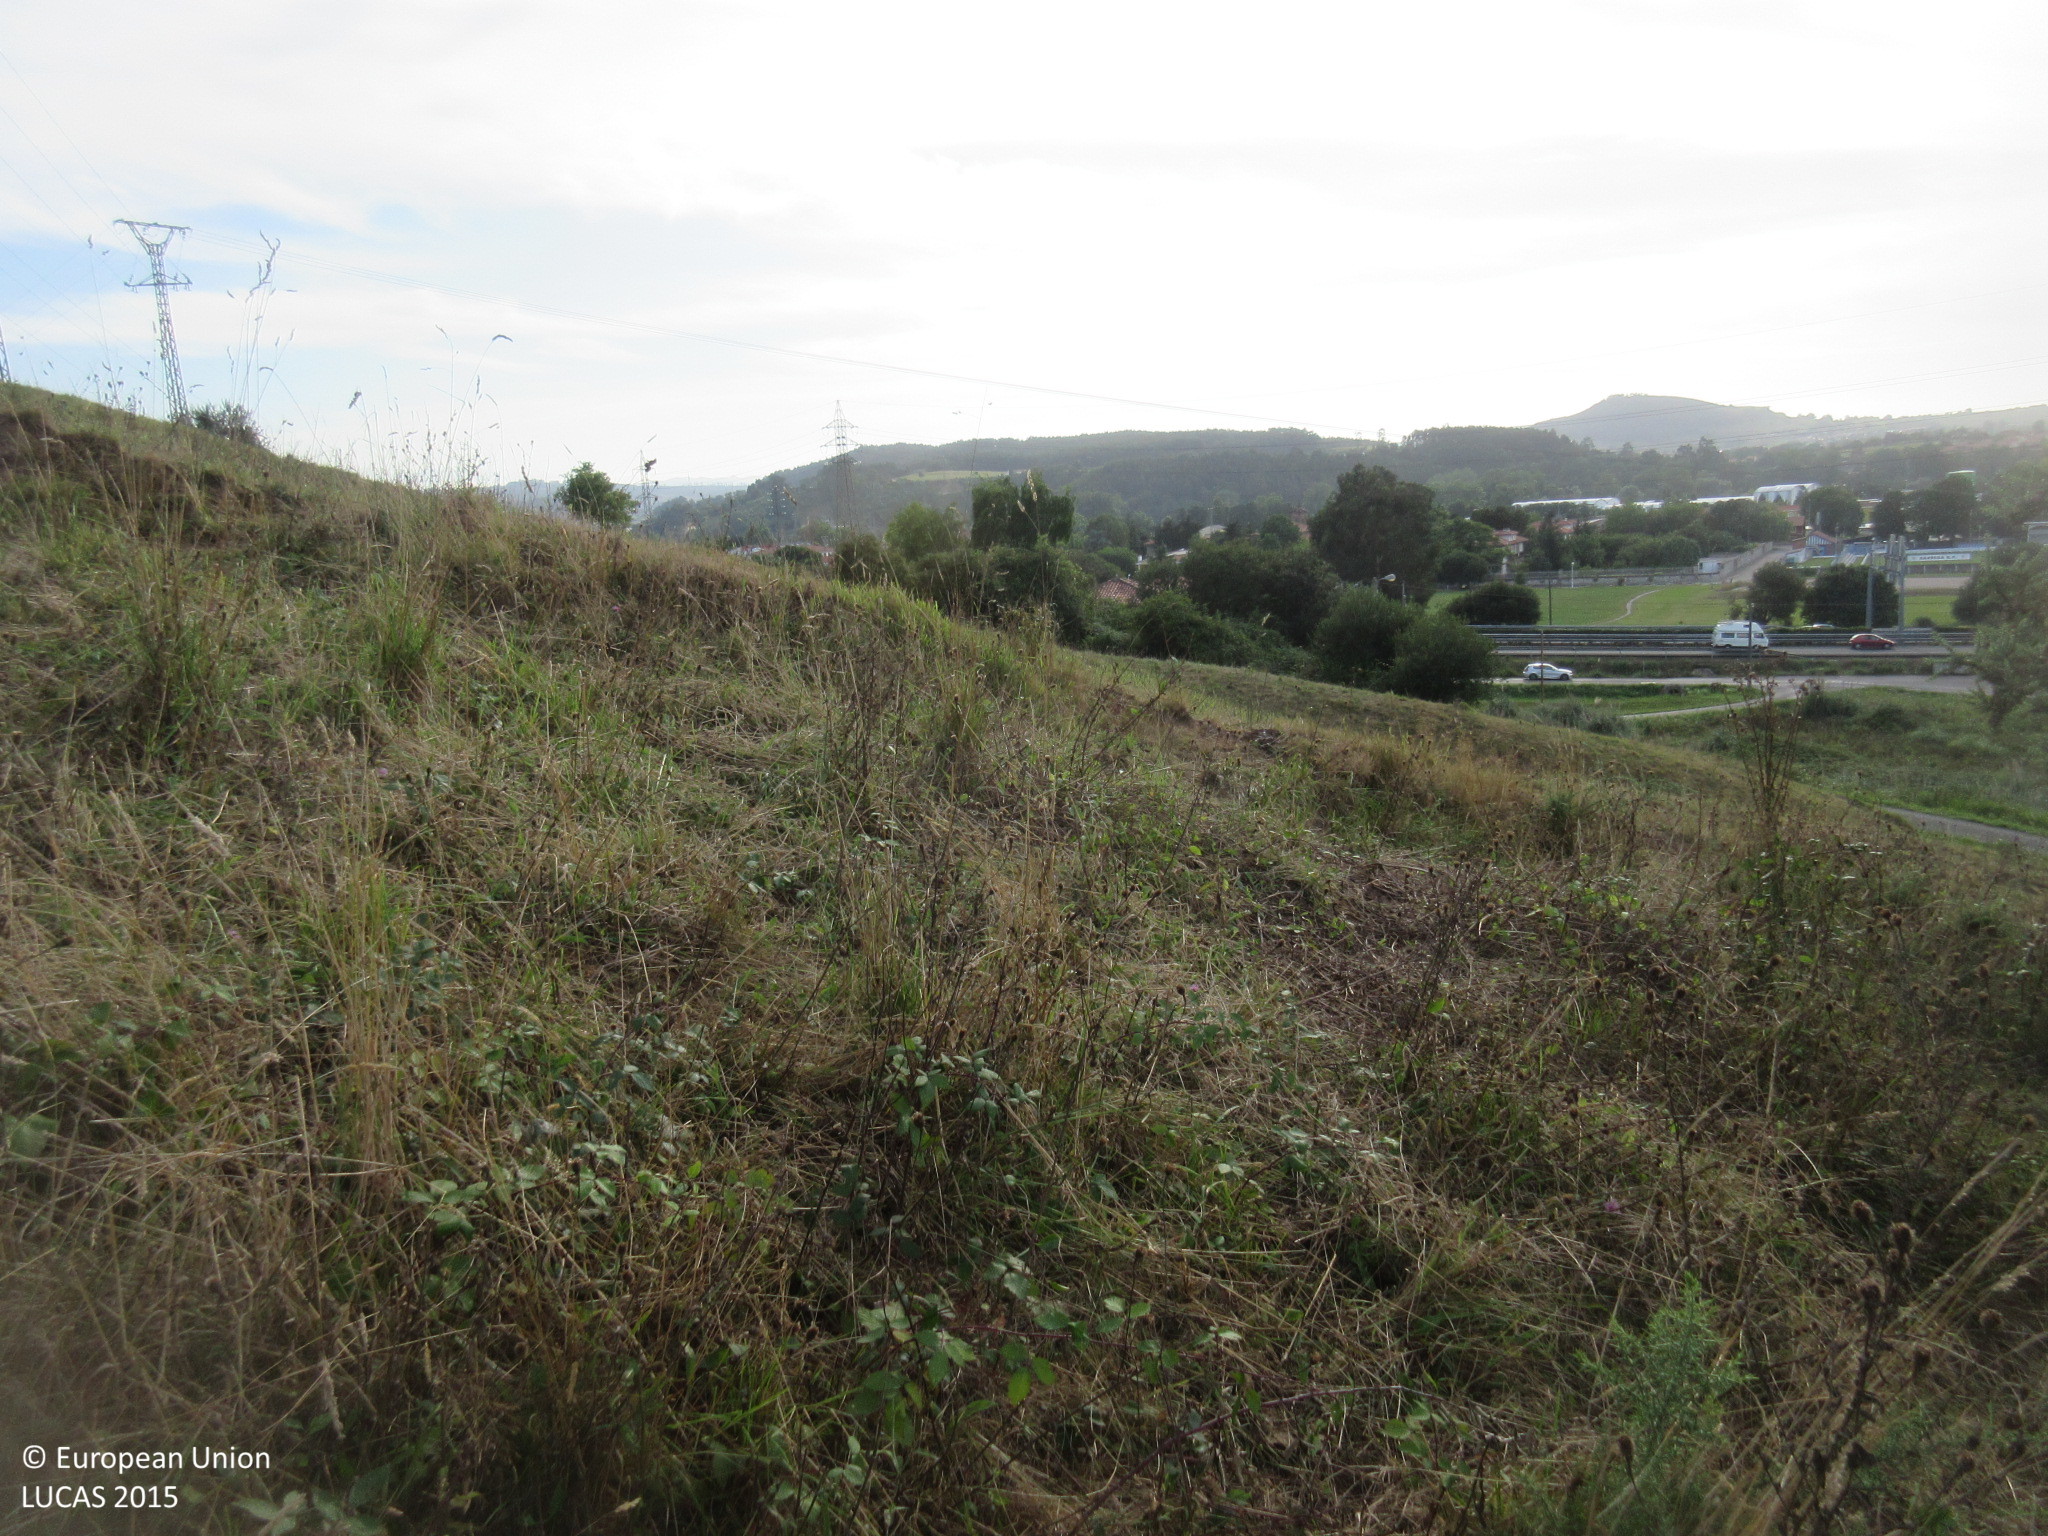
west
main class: Grassland
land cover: Grassland without tree/shrub cover
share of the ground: > 75 %
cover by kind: herbaceous plants 95 %, shrubs 5 %
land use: Agriculture (excluding fallow land and kitchen gardens)
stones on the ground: < 10 %
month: July
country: ES
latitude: 43.3729
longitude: -4.0352
